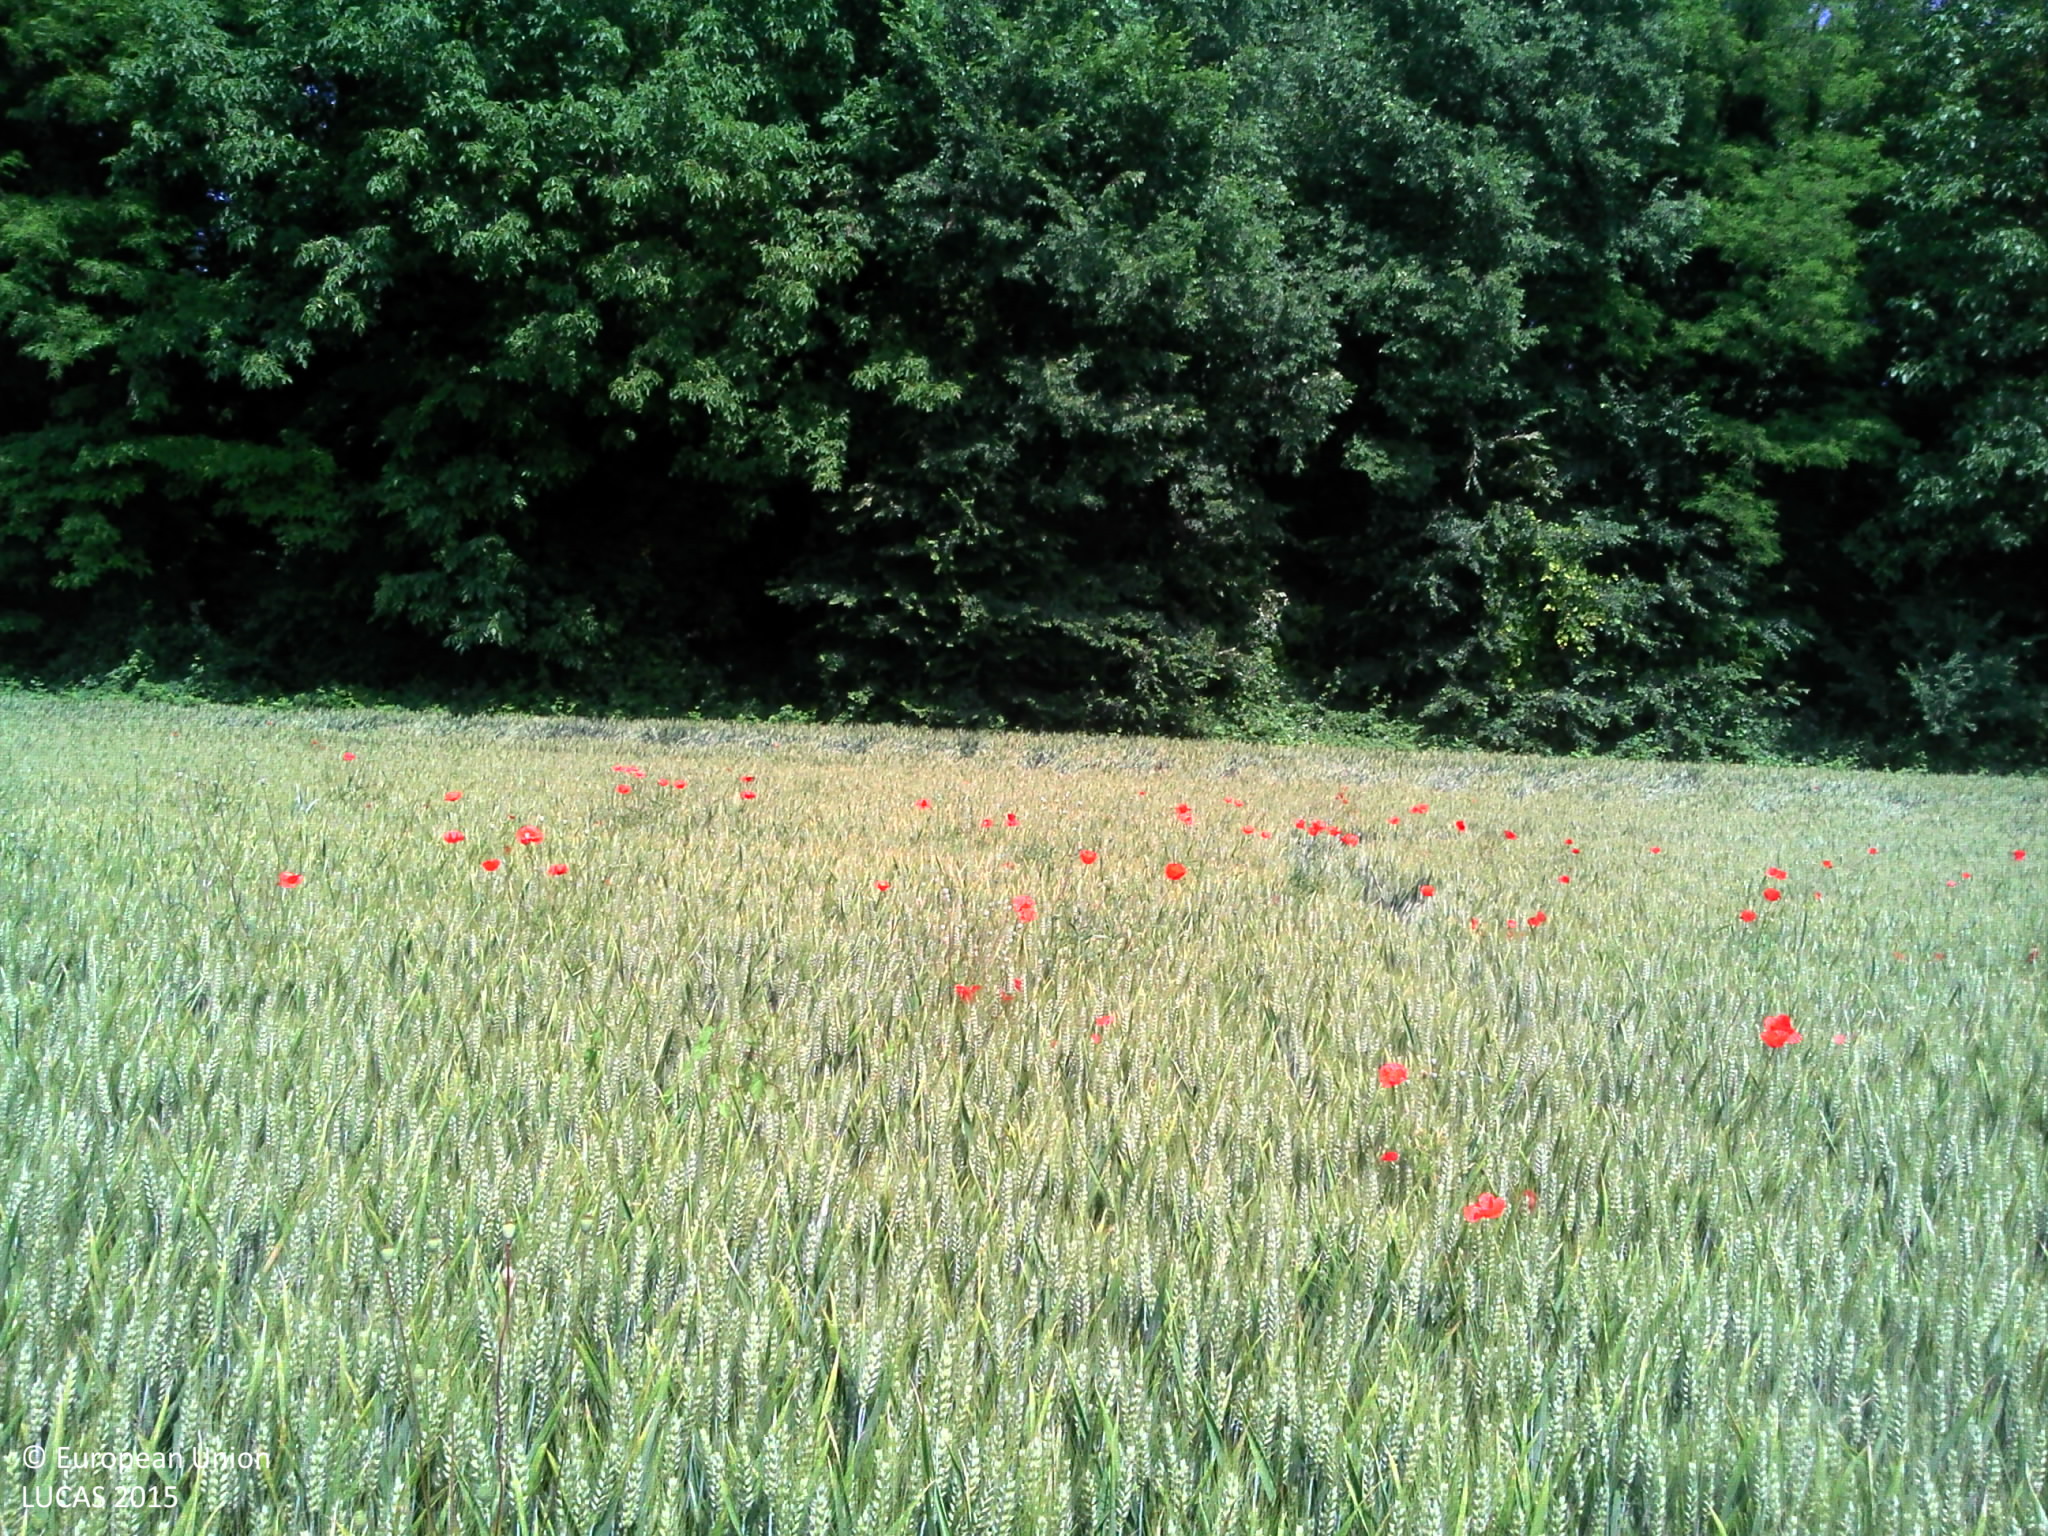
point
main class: Cropland
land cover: Durum wheat
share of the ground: > 75 %
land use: Agriculture (excluding fallow land and kitchen gardens)
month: June
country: FR
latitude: 45.8094
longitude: 5.1782
